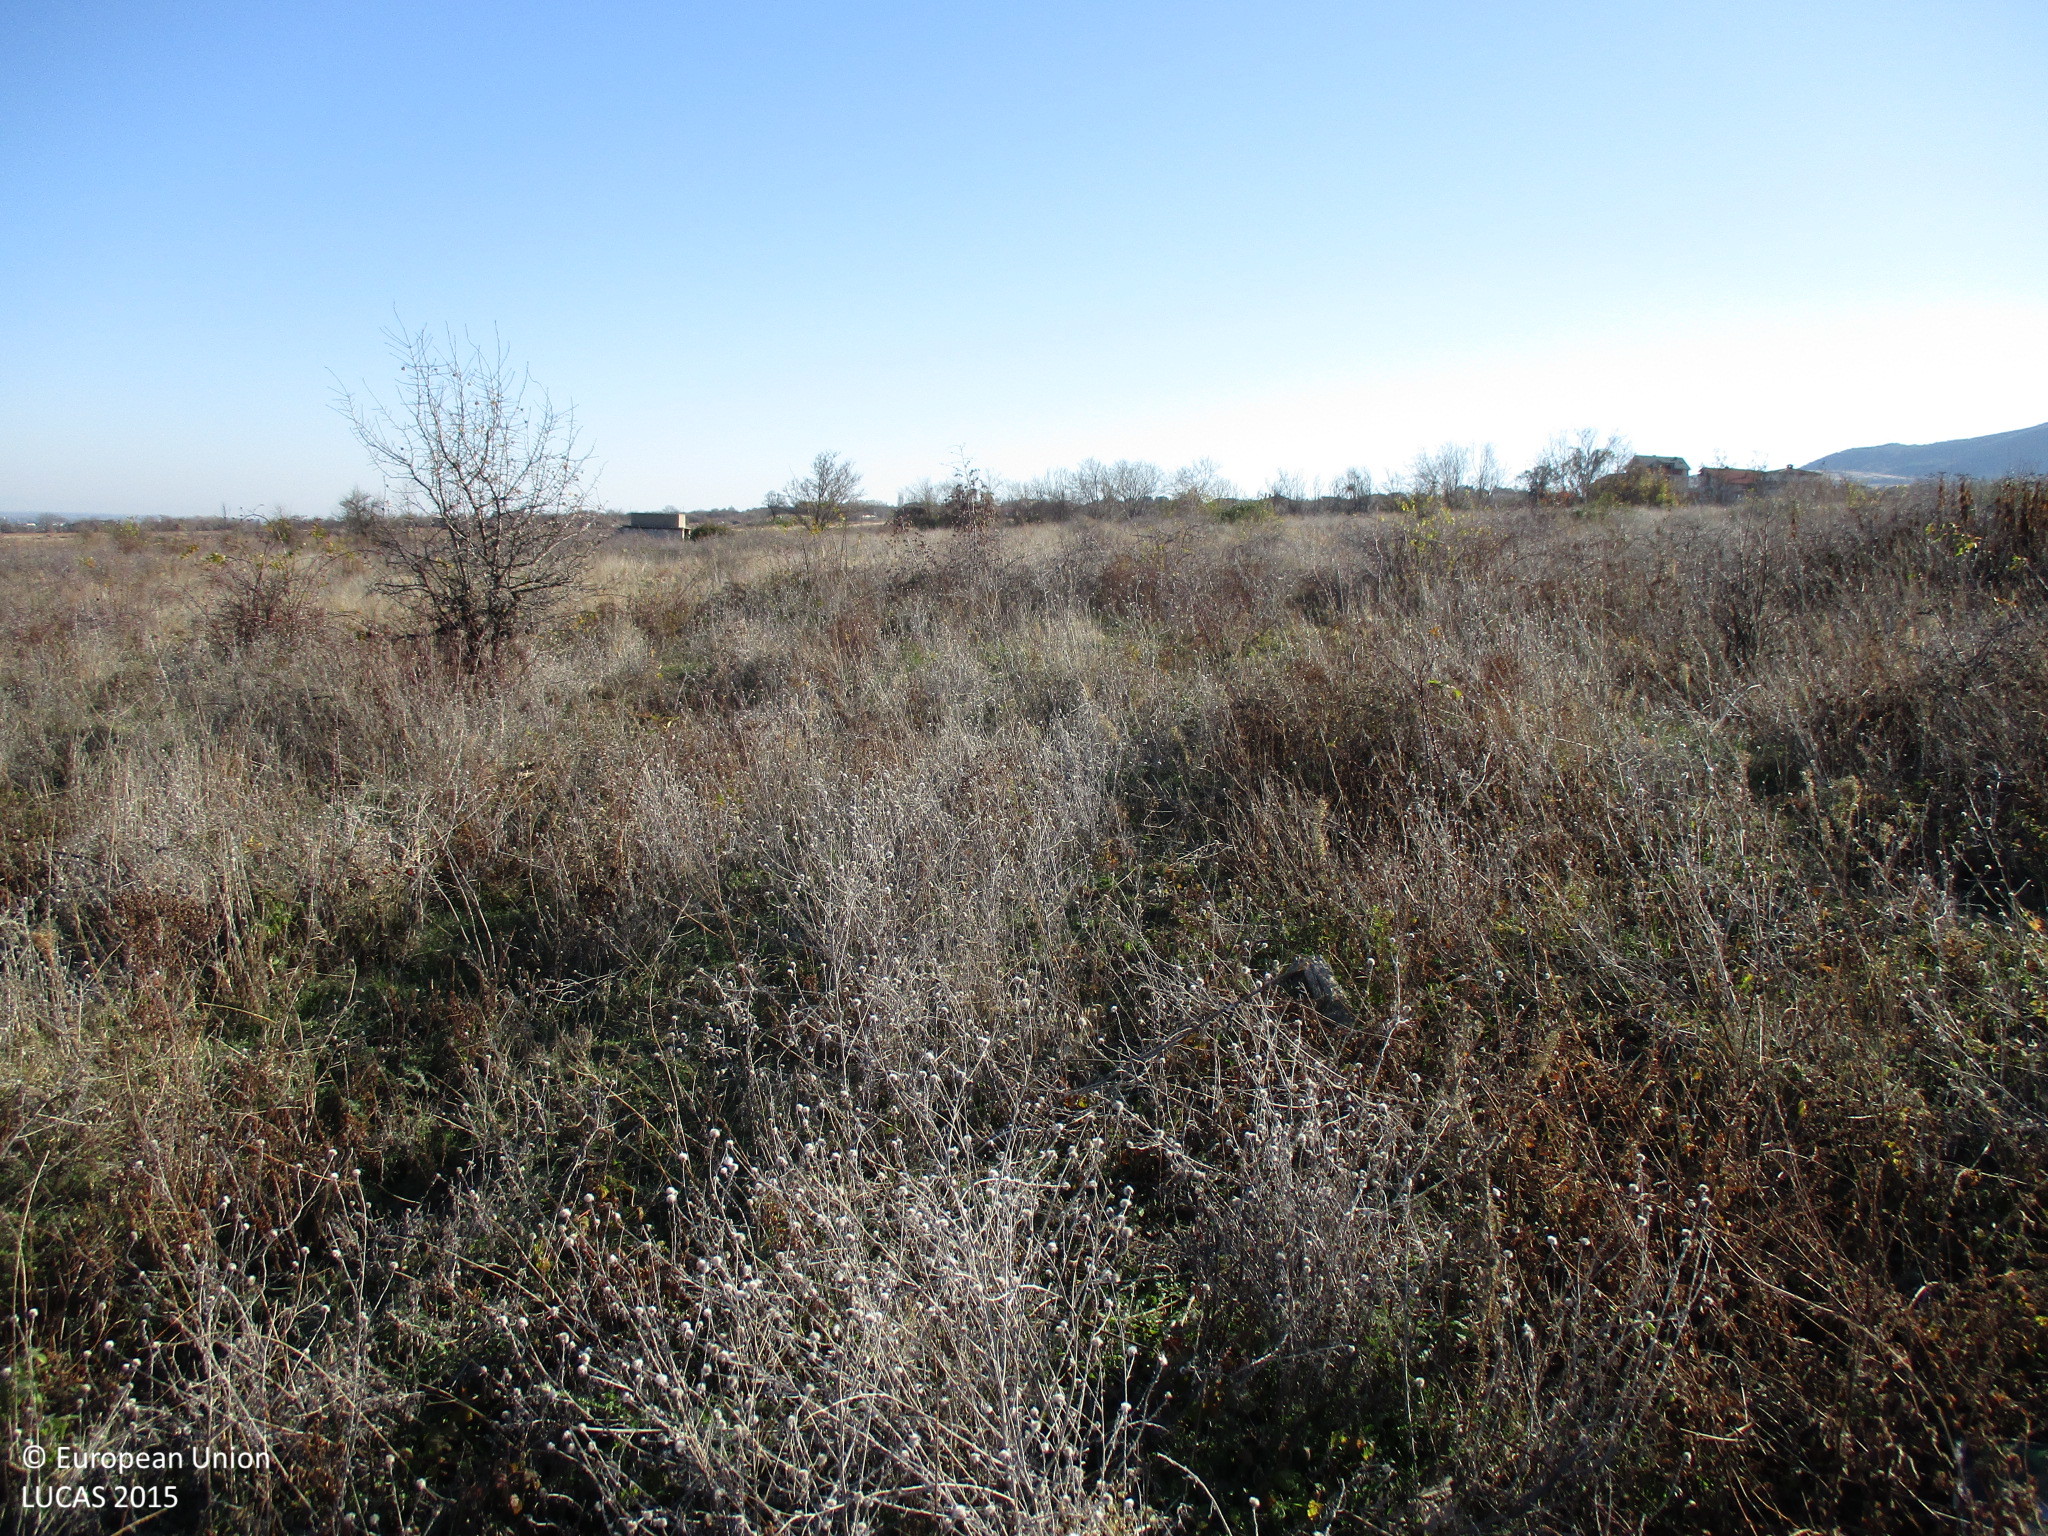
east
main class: Shrubland
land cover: Shrubland without tree cover
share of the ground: > 75 %
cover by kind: shrubs 70 %, herbaceous plants 30 %
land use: Semi-natural and natural areas not in use
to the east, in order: Shrubland without tree cover; Tracks; Grass margins; Broadleaved woodland; Ditches and canals; Broadleaved woodland; Spontaneously vegetated surfaces; Shrubland without tree cover
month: December
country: BG
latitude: 42.0717
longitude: 24.6860
